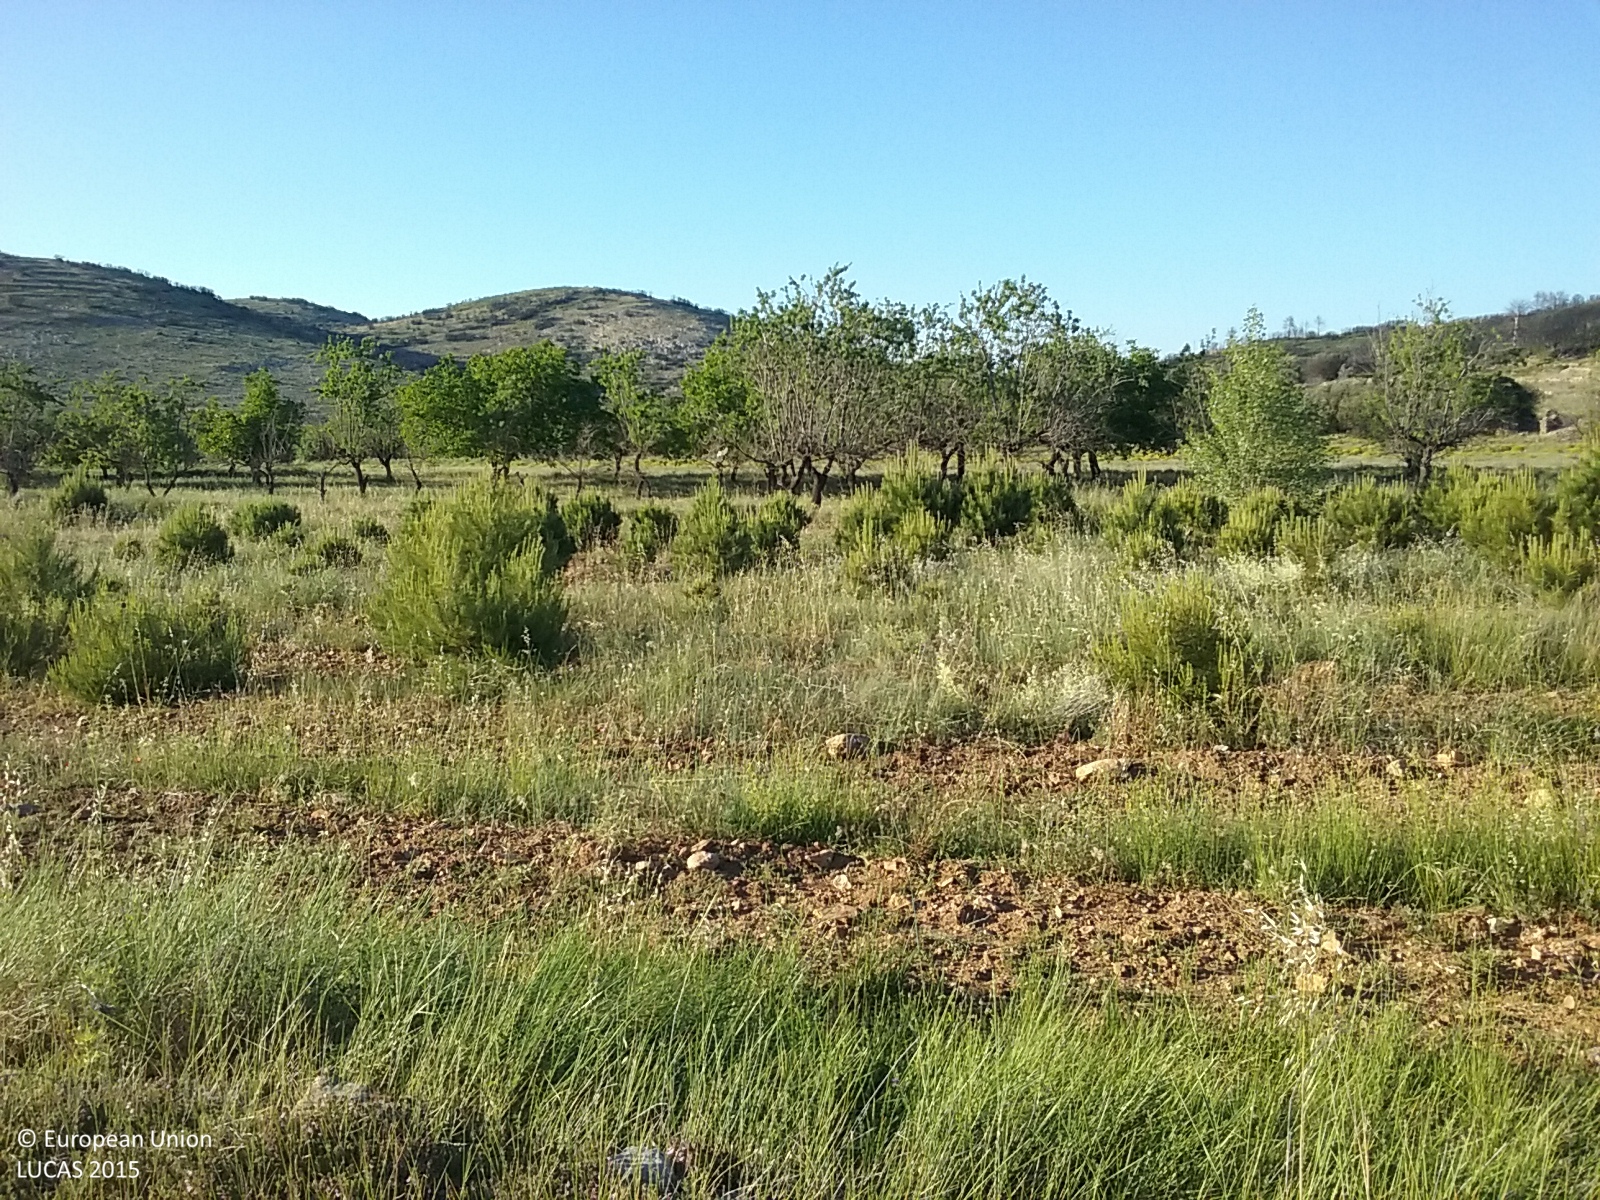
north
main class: Grassland
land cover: Spontaneously vegetated surfaces
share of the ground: > 75 %
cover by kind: herbaceous plants 90 %, shrubs 5 %, unconsolidated bare surface 5 %
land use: Abandoned areas
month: June
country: ES
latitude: 39.8450
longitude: -0.6963
